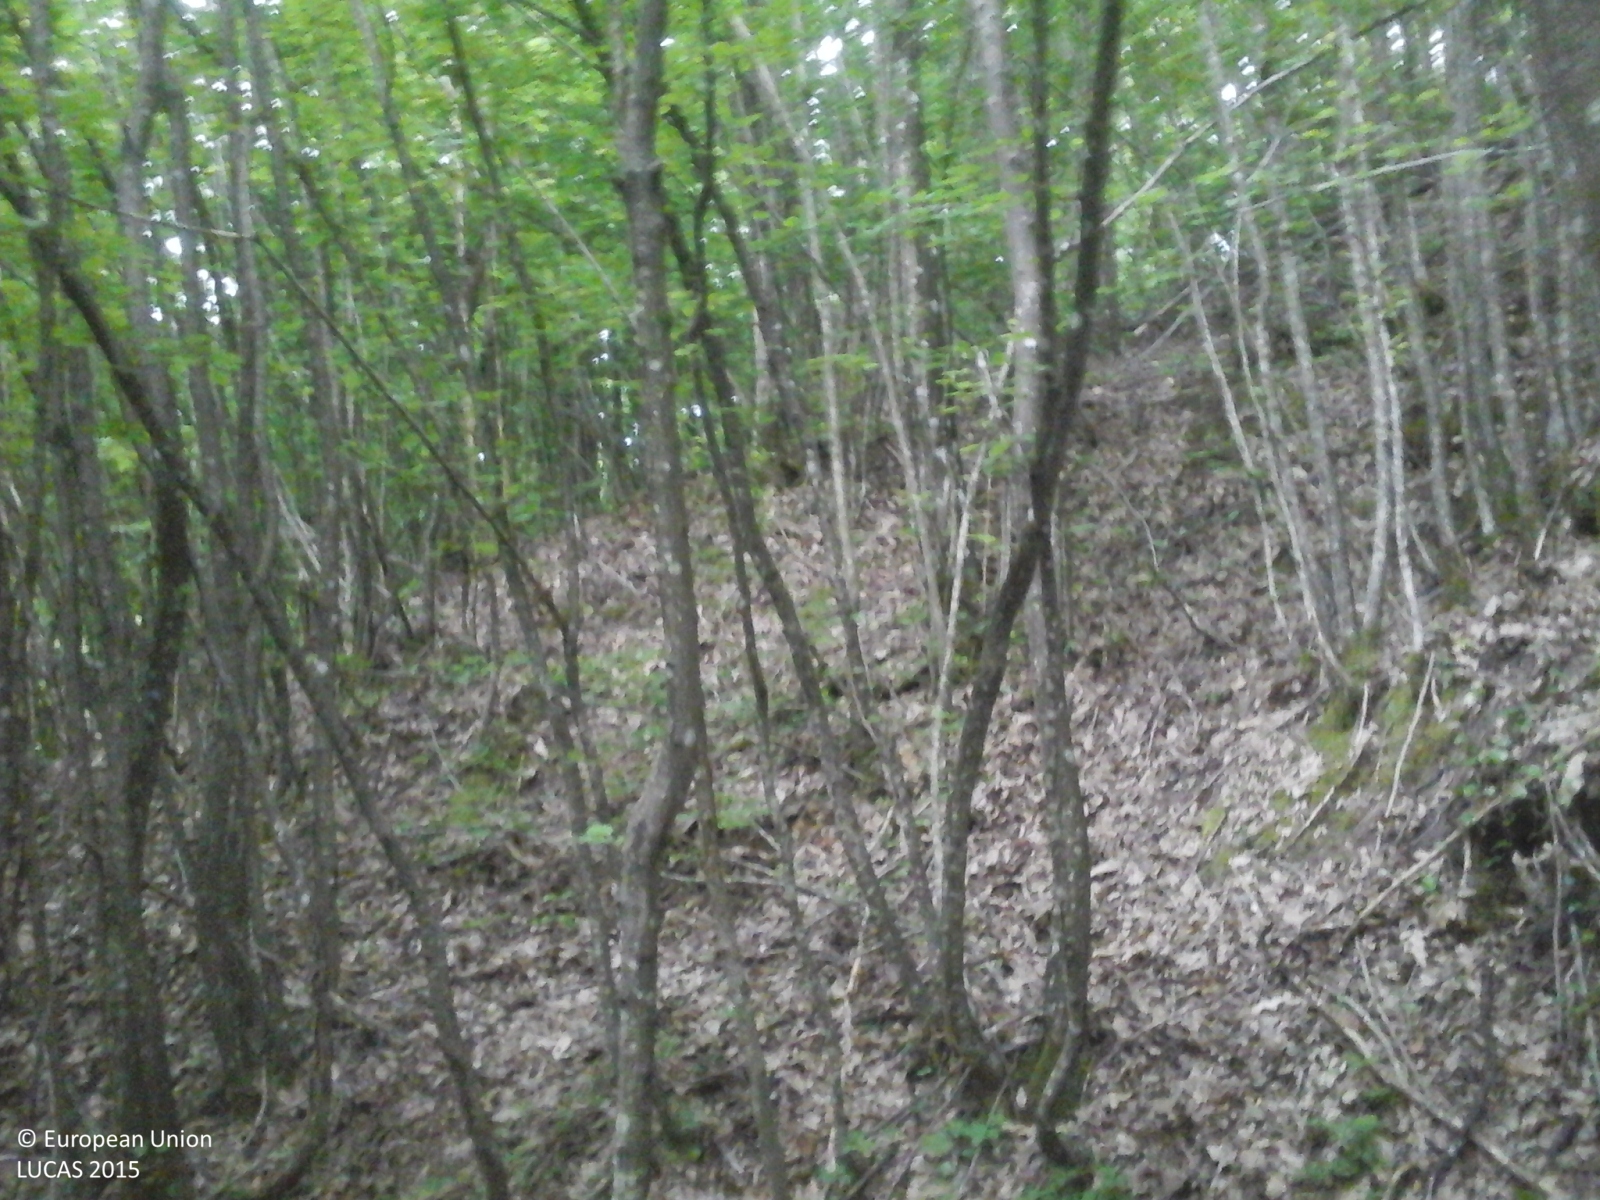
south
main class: Woodland
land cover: Broadleaved woodland
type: thermophilous deciduous forest
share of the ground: > 75 %
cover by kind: broadleaved forest trees 100 %
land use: Forestry
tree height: > 5 m
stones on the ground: 10 - 25 %
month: May
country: IT
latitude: 44.2739
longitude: 10.9625
